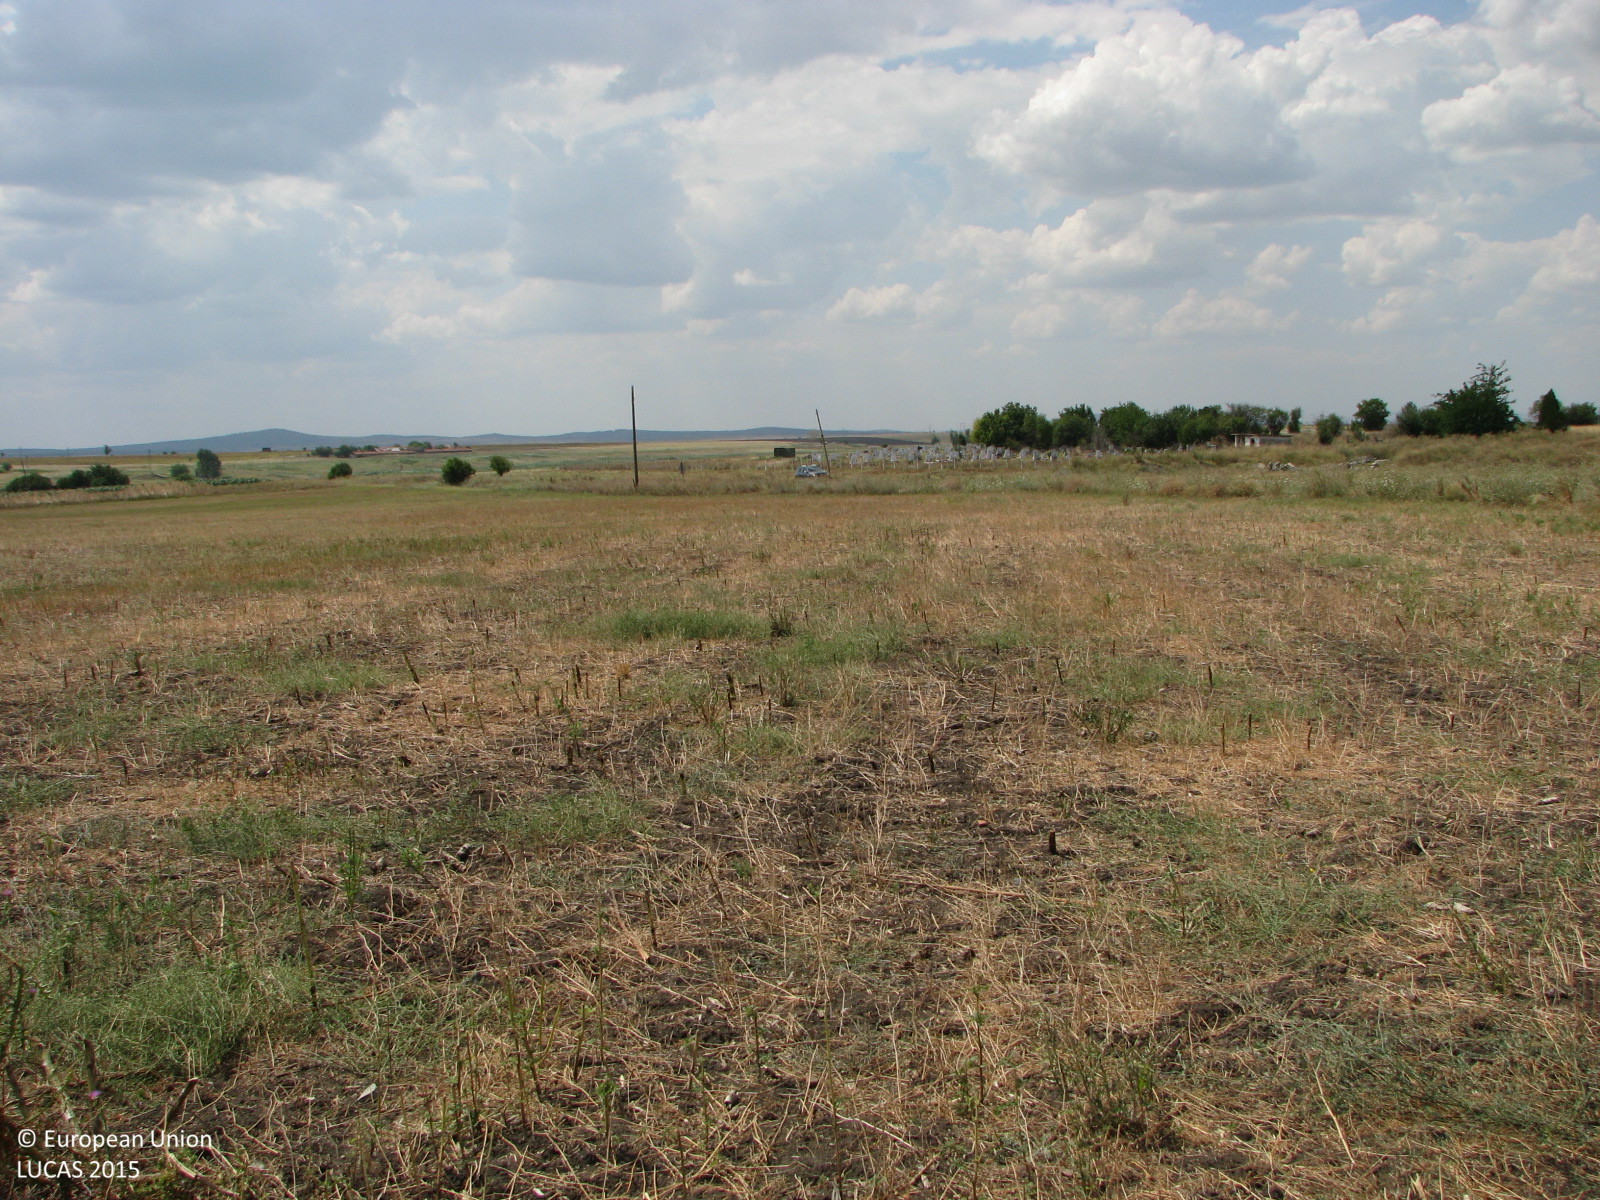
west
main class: Cropland
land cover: Other non-permanent industrial crops
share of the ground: < 10 %
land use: Agriculture (excluding fallow land and kitchen gardens)
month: August
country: BG
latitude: 42.3911
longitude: 26.4027
